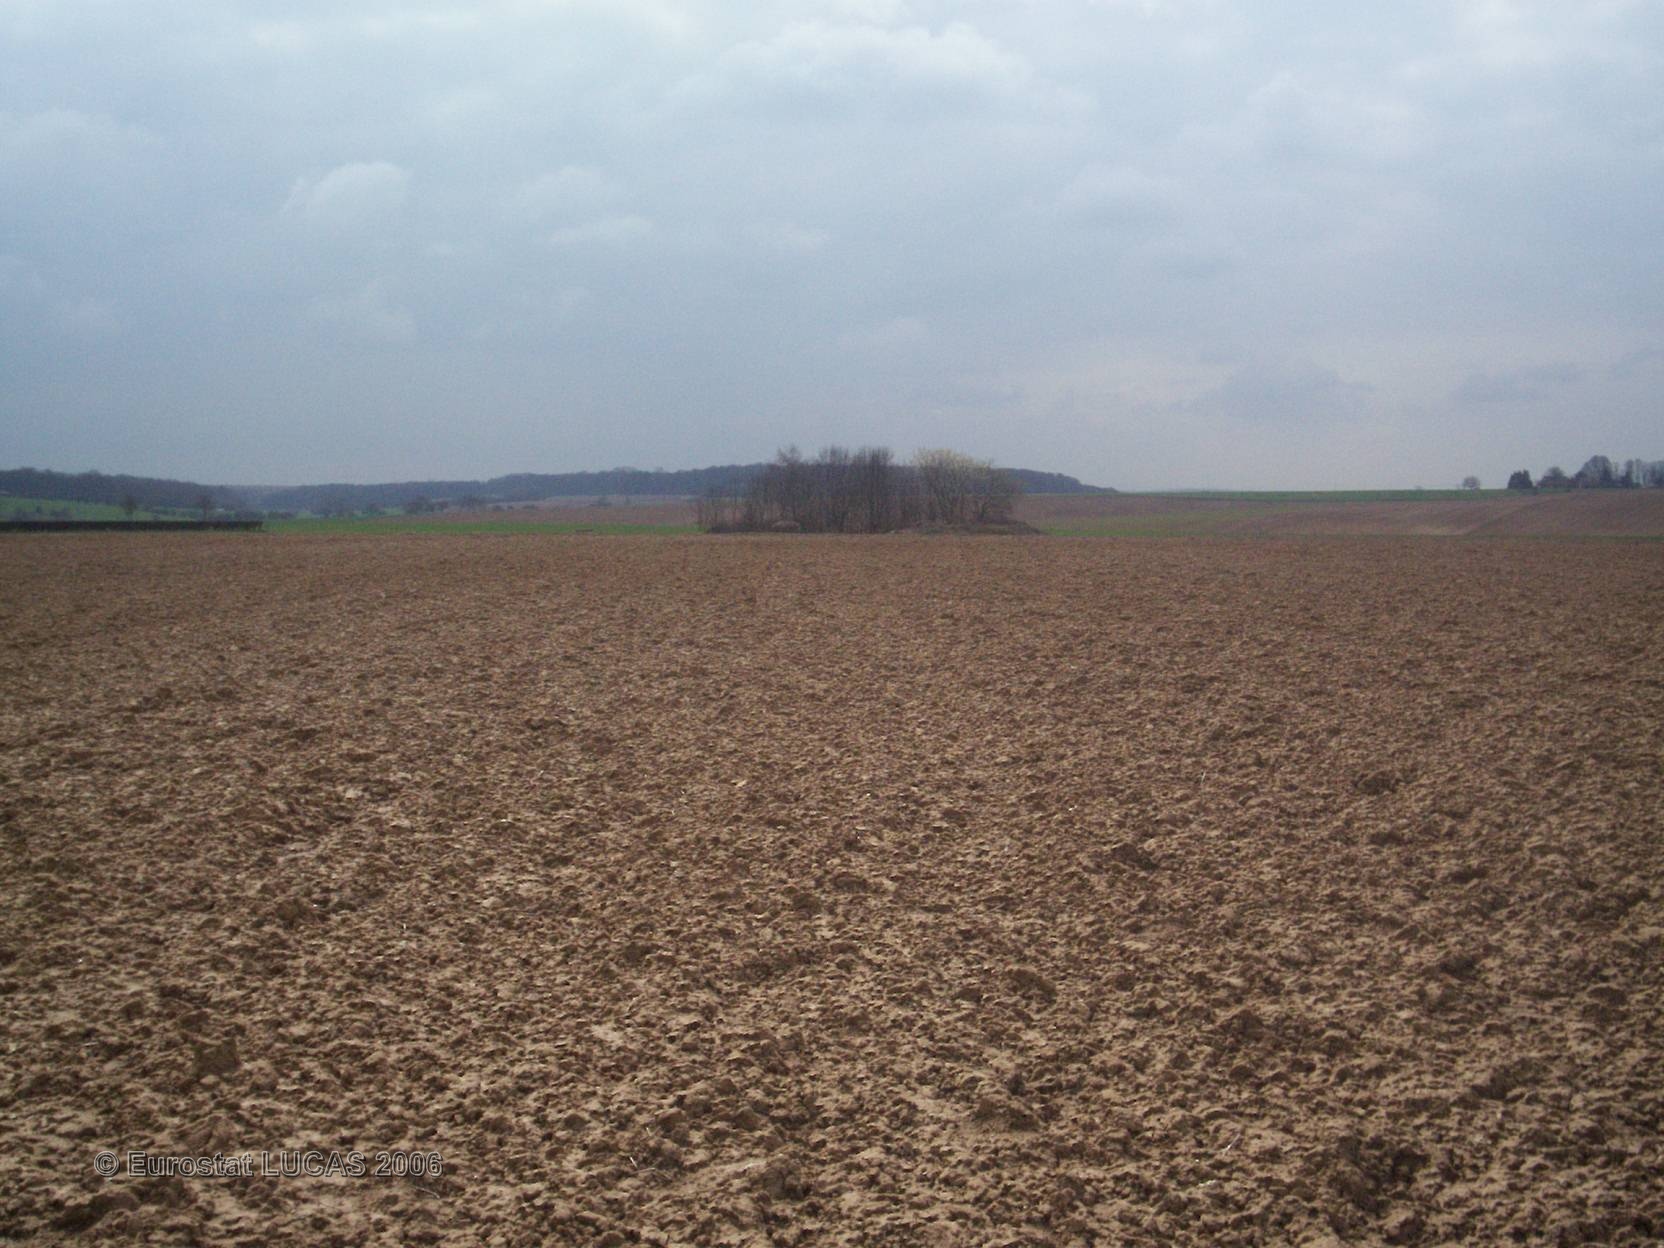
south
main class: Cropland
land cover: Potatoes
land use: Agriculture (excluding fallow land and kitchen gardens)
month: June
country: FR
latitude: 50.0877
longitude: 2.5944
